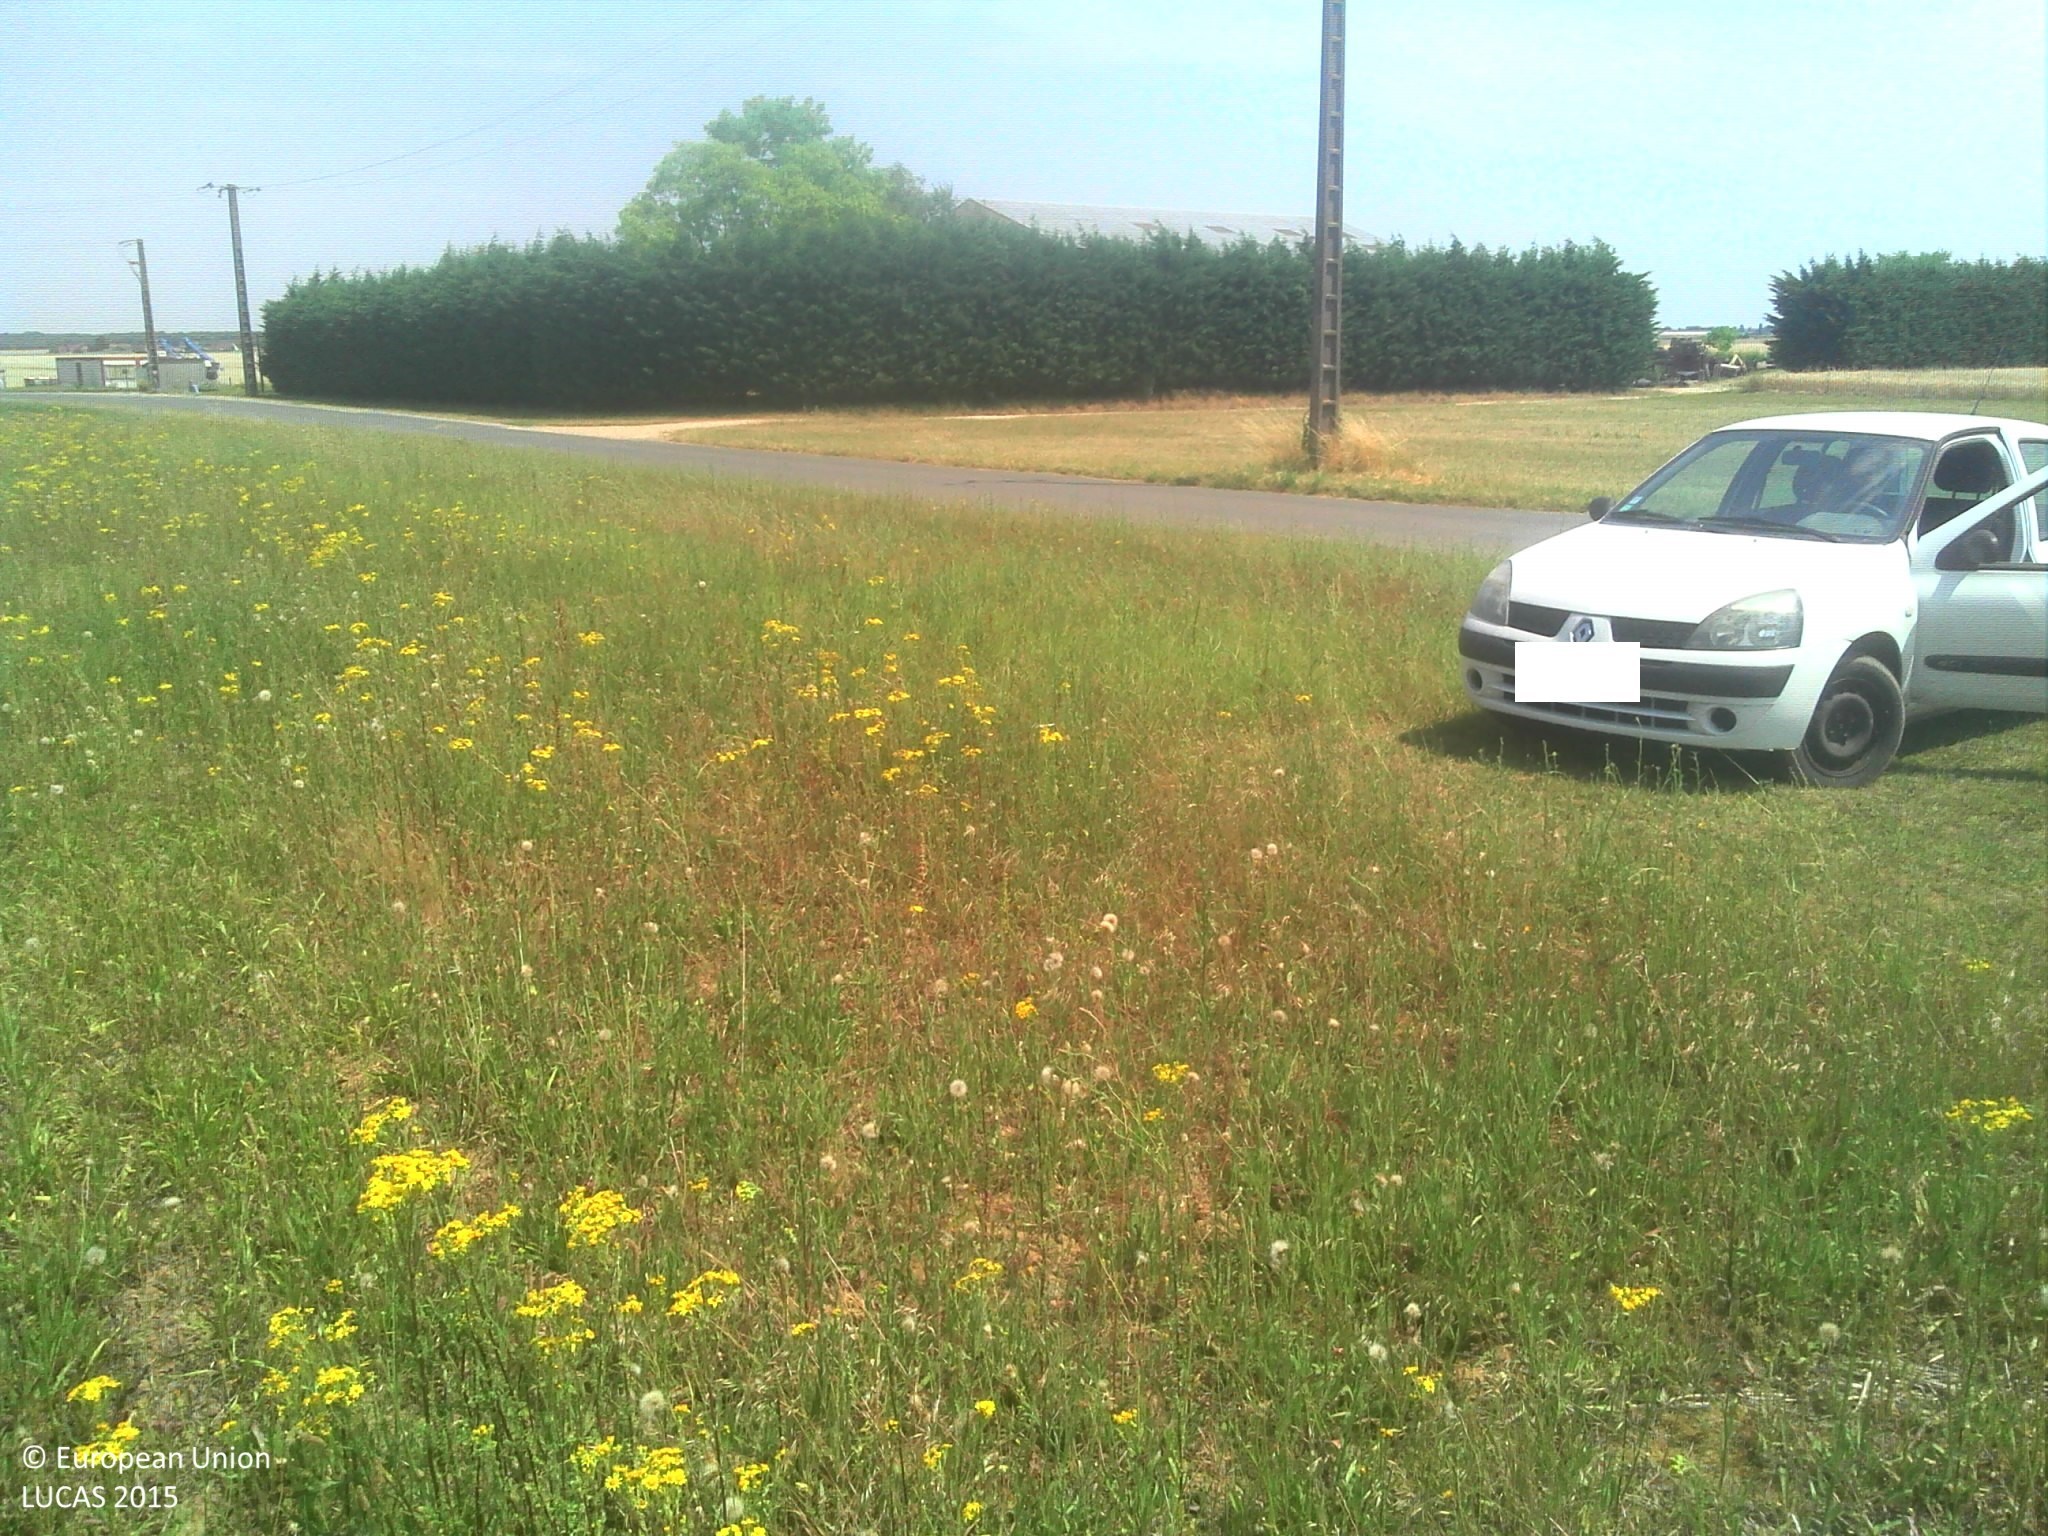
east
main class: Grassland
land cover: Spontaneously vegetated surfaces
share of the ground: > 75 %
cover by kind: herbaceous plants 100 %
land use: Agriculture (excluding fallow land and kitchen gardens)
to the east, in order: Spontaneously vegetated surfaces; Paved roads, cycling and walking lanes; Grass margins; Electric lines; Conifer hedges; Artificial constructions in urban areas; Grass margins; Durum wheat
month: July
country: FR
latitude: 47.6474
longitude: 1.3448
